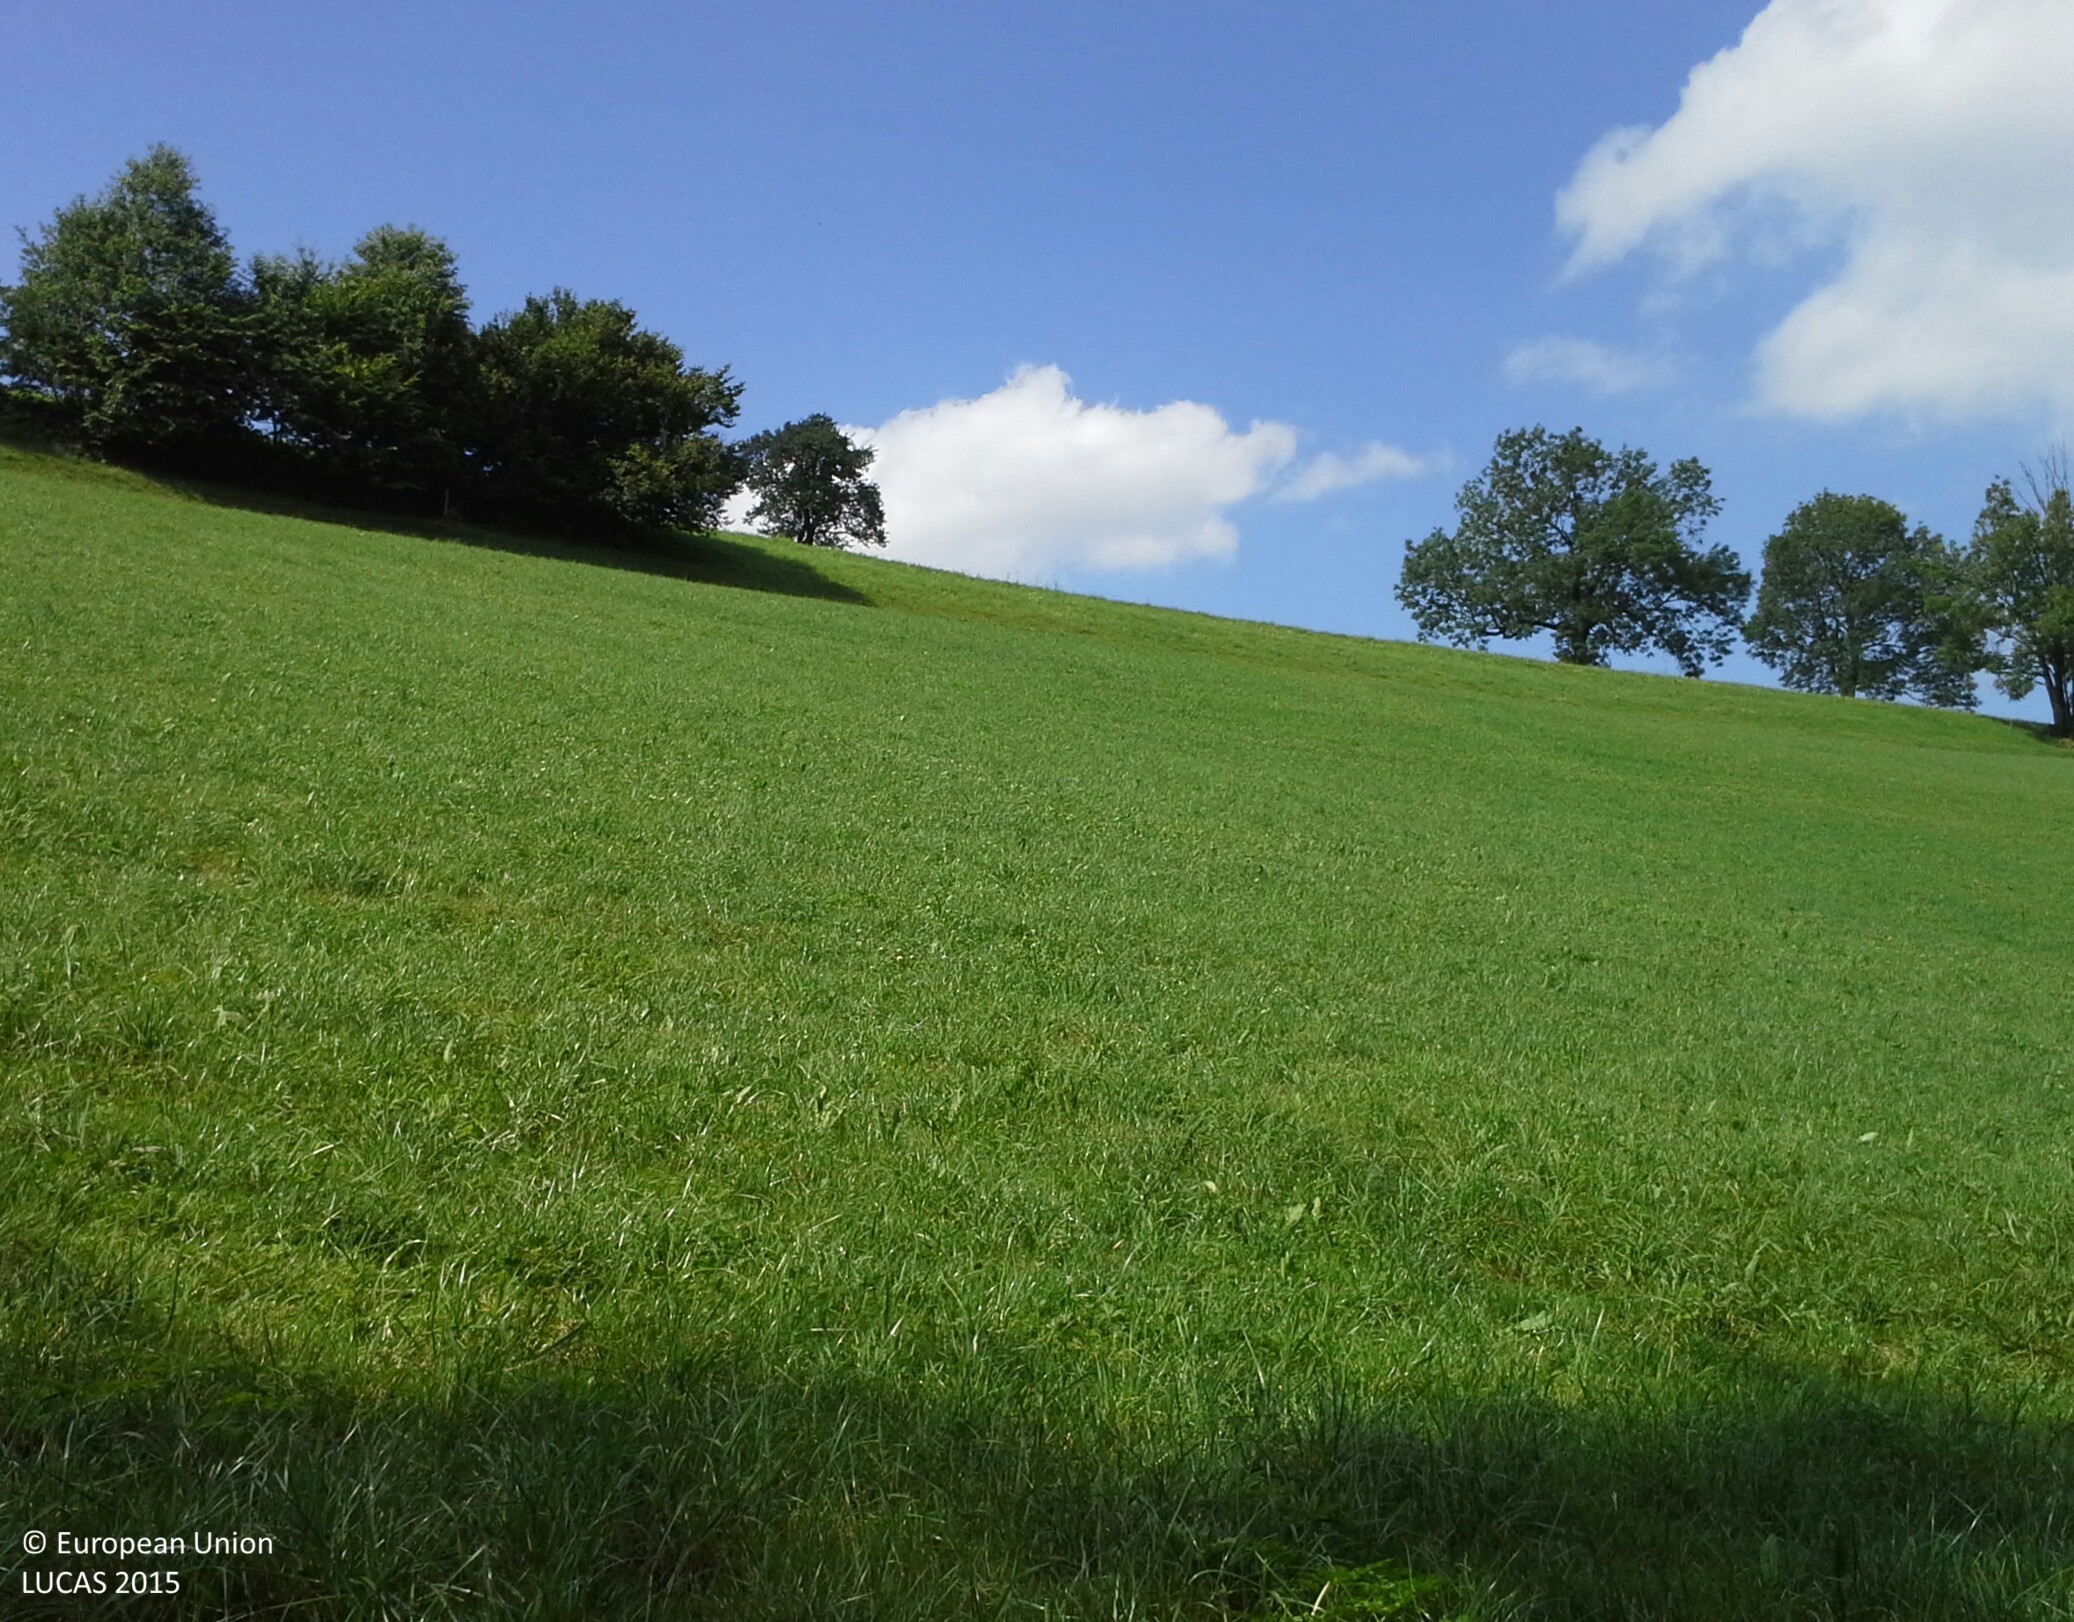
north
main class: Grassland
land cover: Grassland without tree/shrub cover
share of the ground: > 75 %
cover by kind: herbaceous plants 90 %, lichens and mosses 10 %
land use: Agriculture (excluding fallow land and kitchen gardens)
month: July
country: AT
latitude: 47.9477
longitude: 14.5925
